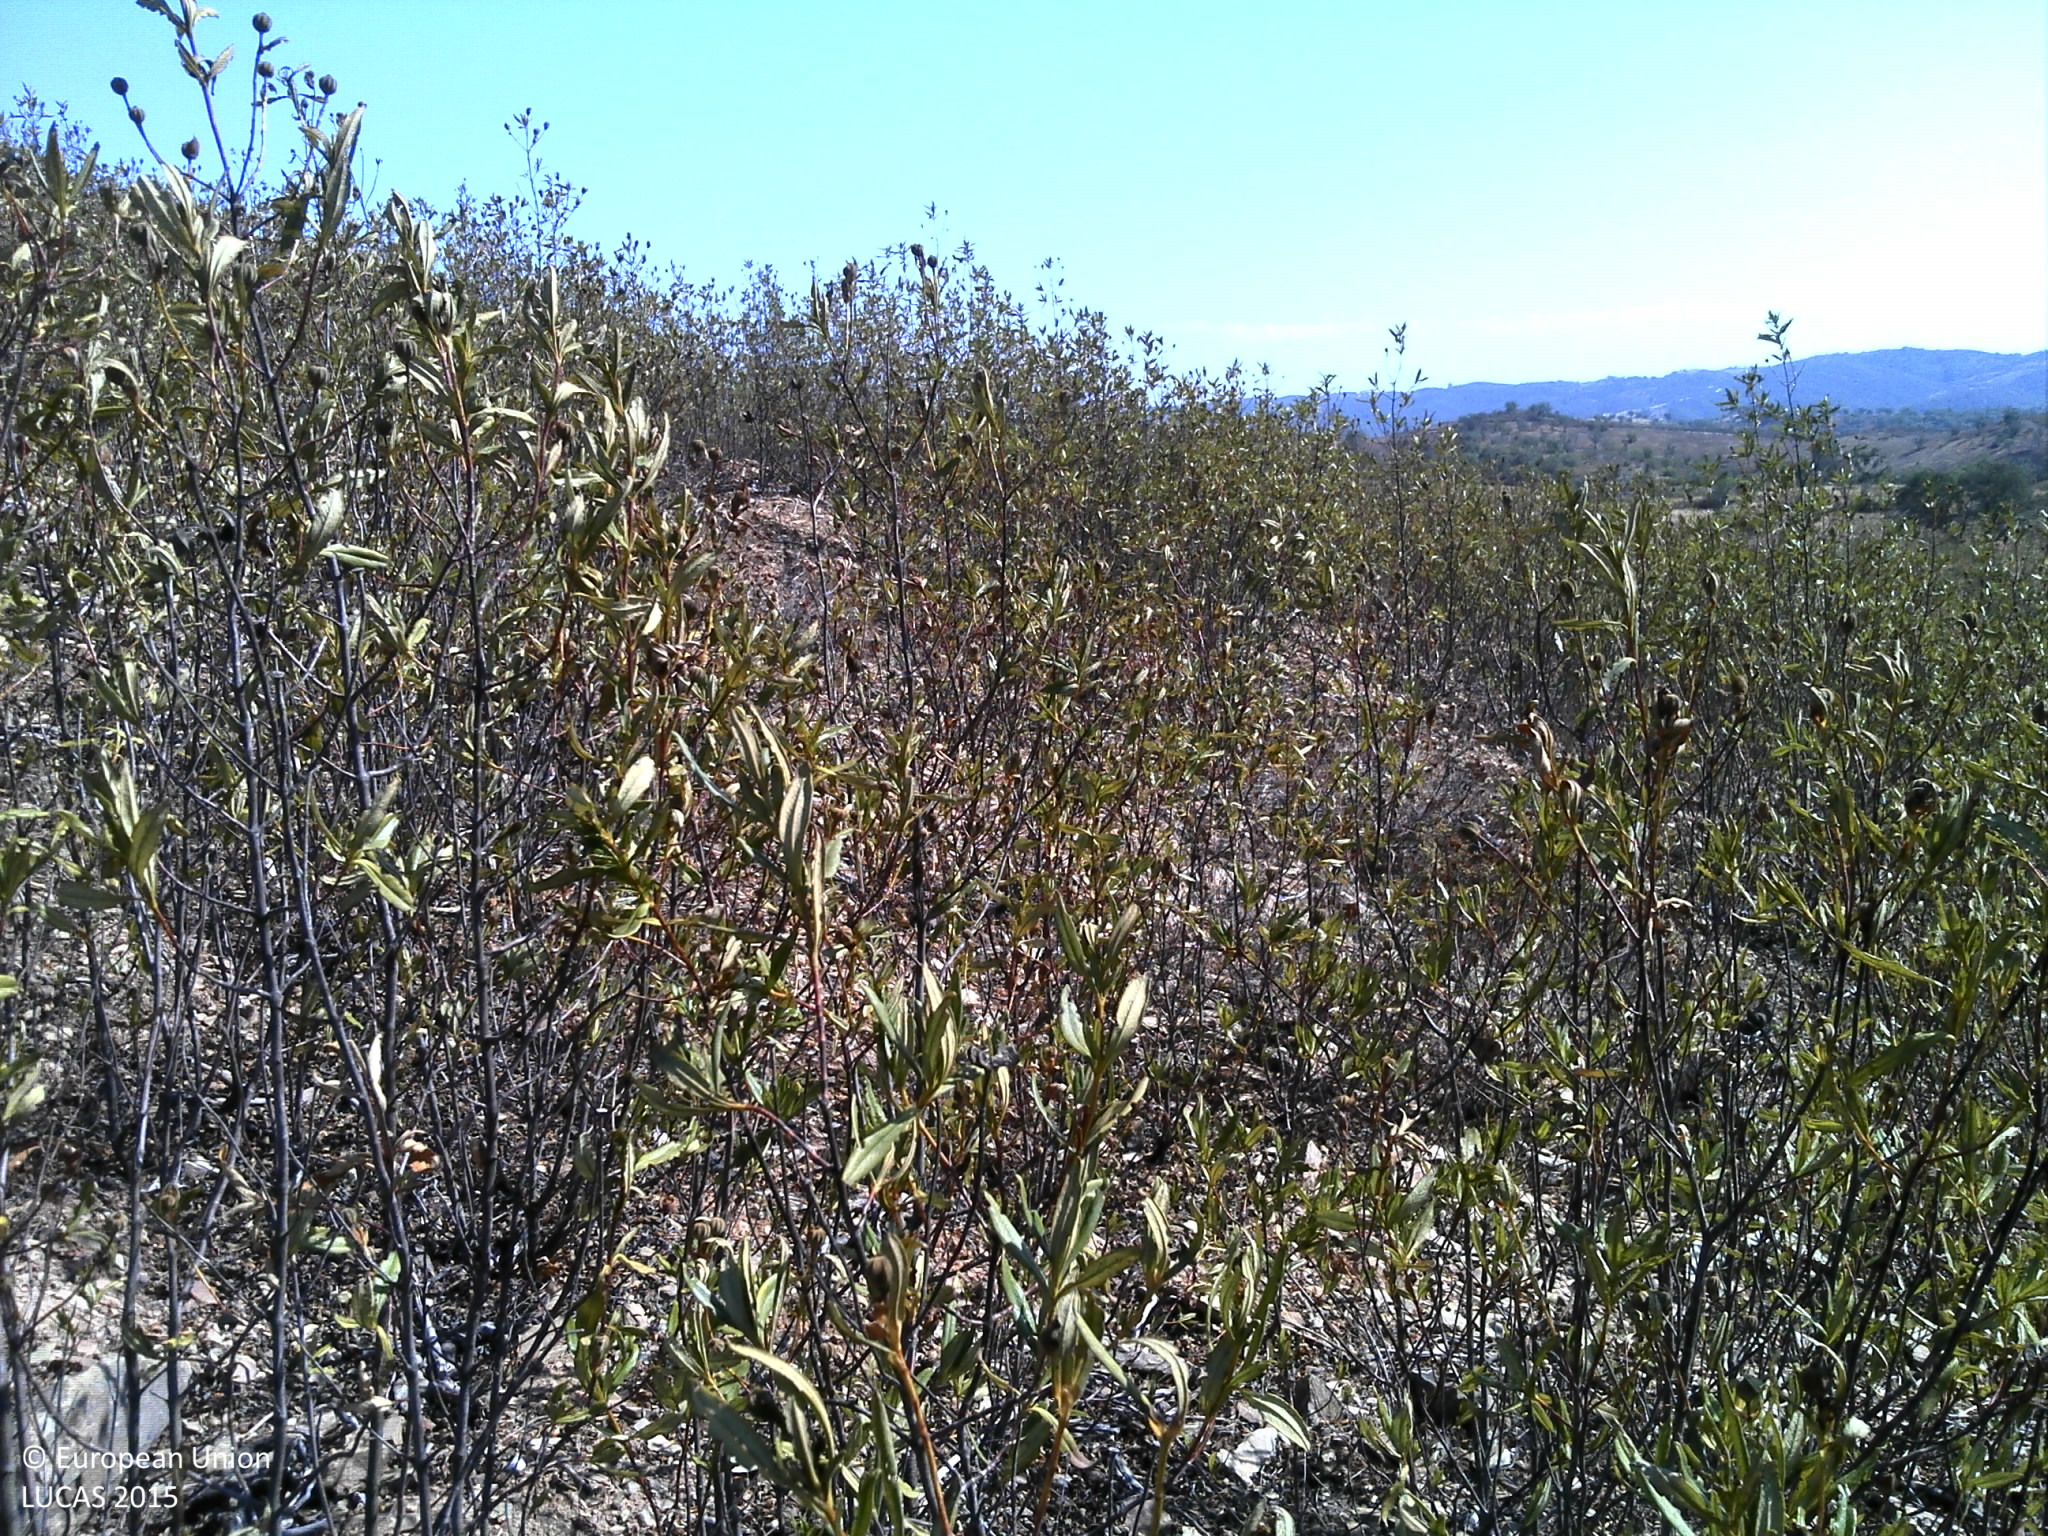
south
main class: Shrubland
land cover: Shrubland without tree cover
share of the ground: 25 - 50 %
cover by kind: unconsolidated bare surface 55 %, shrubs 45 %
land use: Abandoned areas
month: September
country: PT
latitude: 37.4586
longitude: -8.1916
